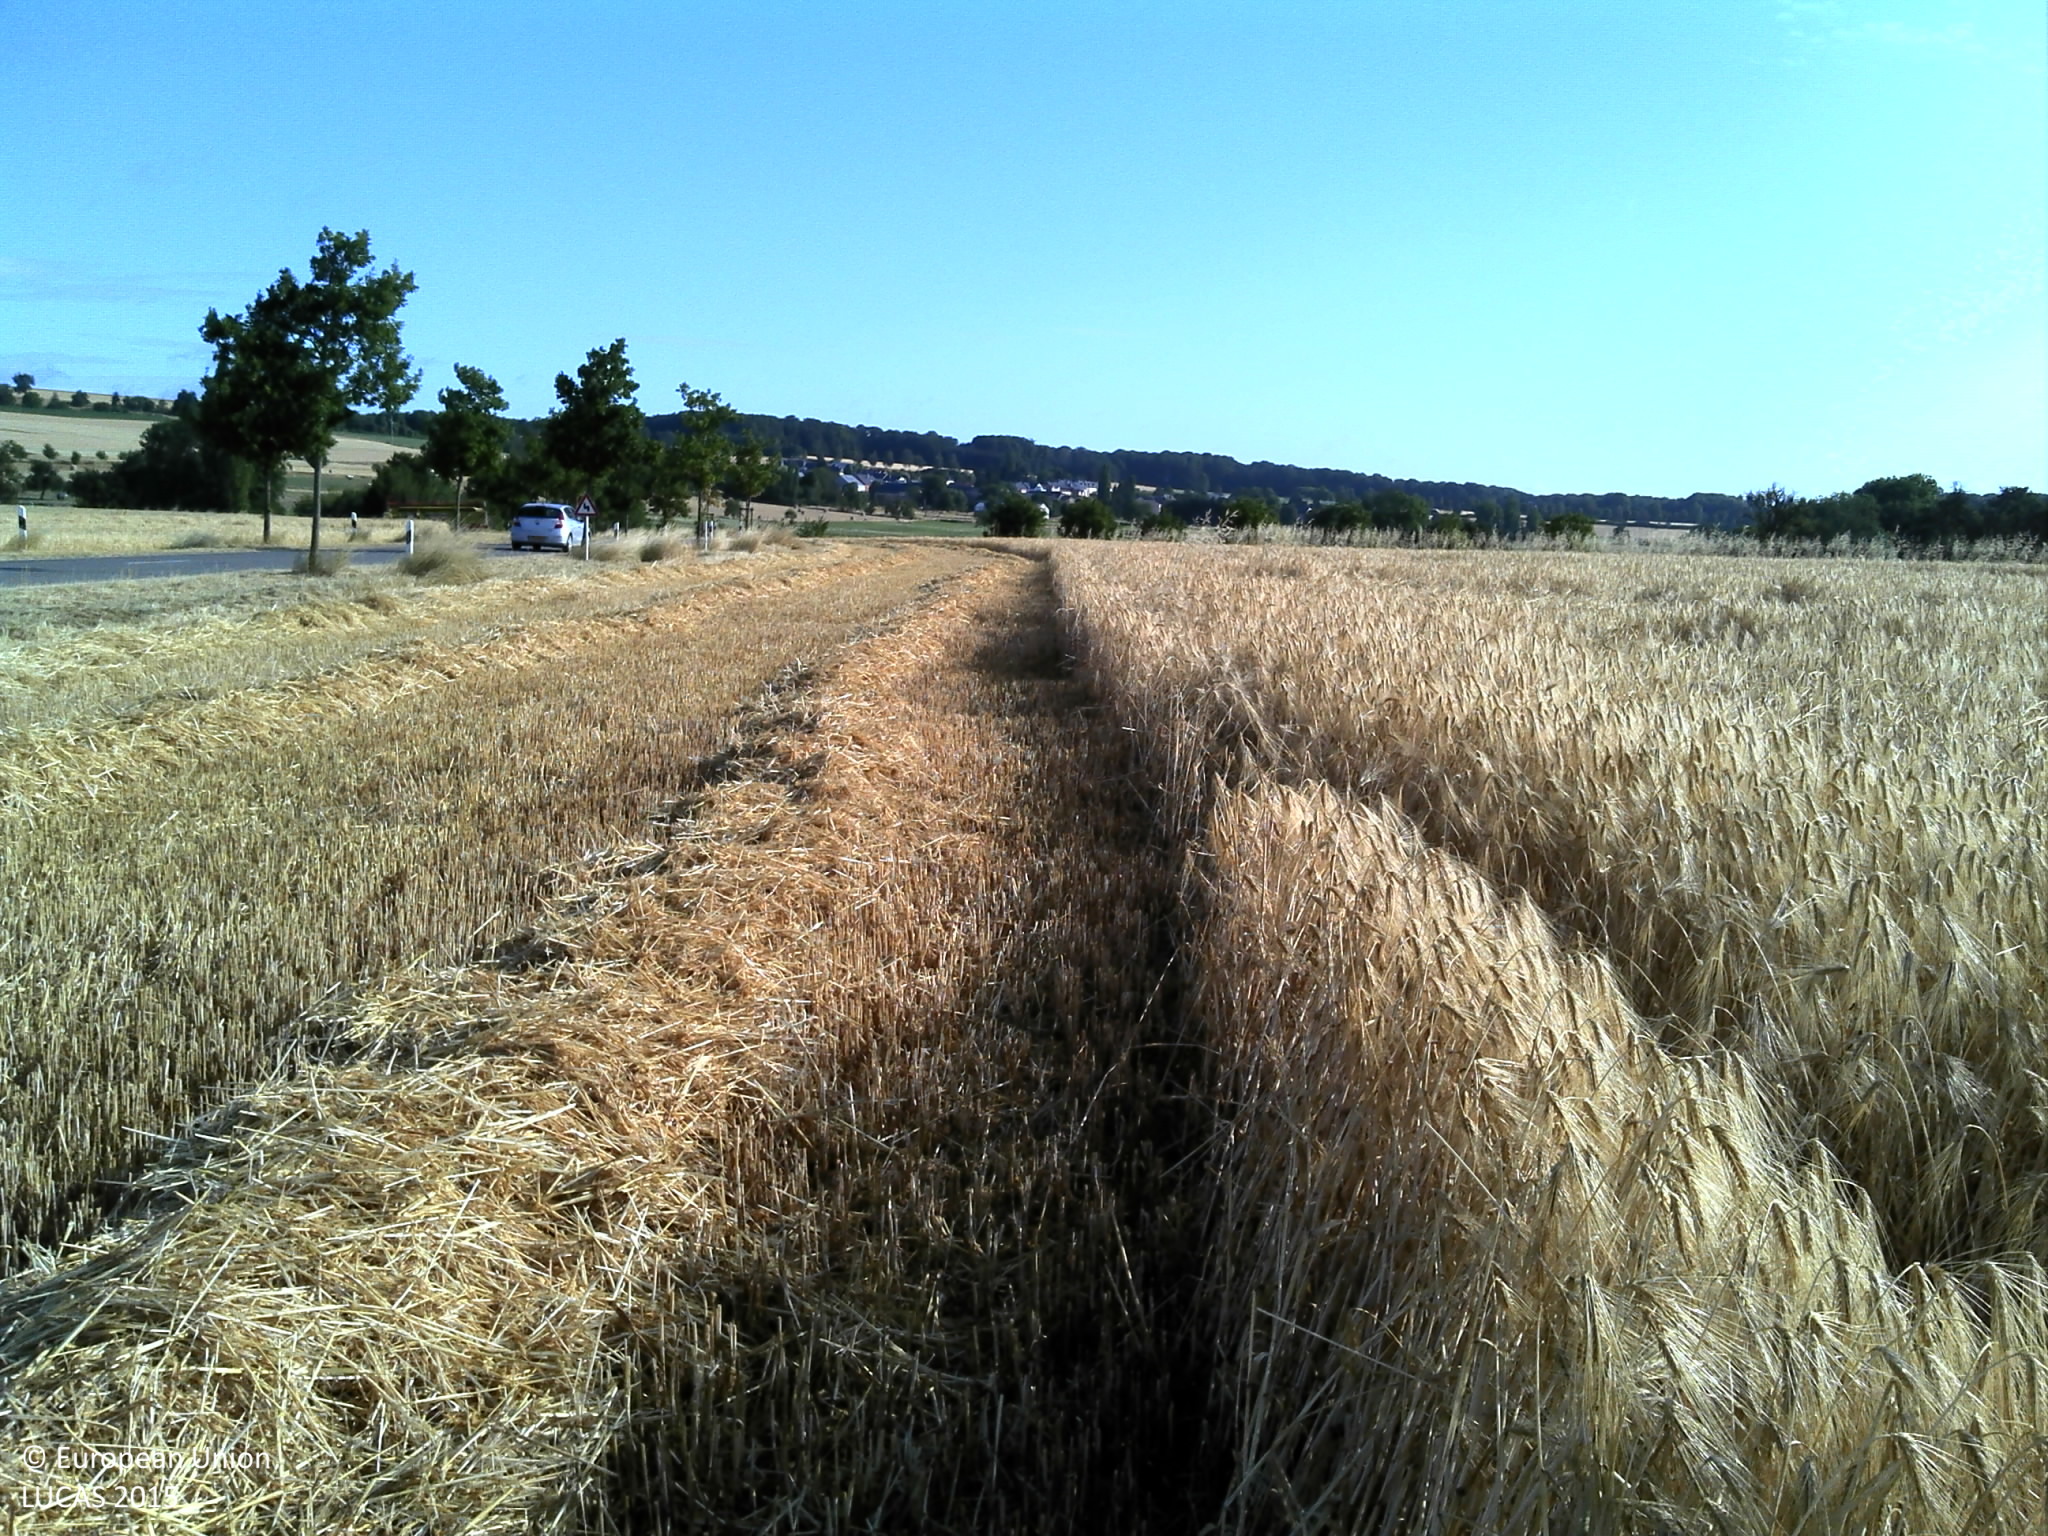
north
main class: Cropland
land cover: Barley
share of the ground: > 75 %
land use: Agriculture (excluding fallow land and kitchen gardens)
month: July
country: LU
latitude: 49.5296
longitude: 6.2830
